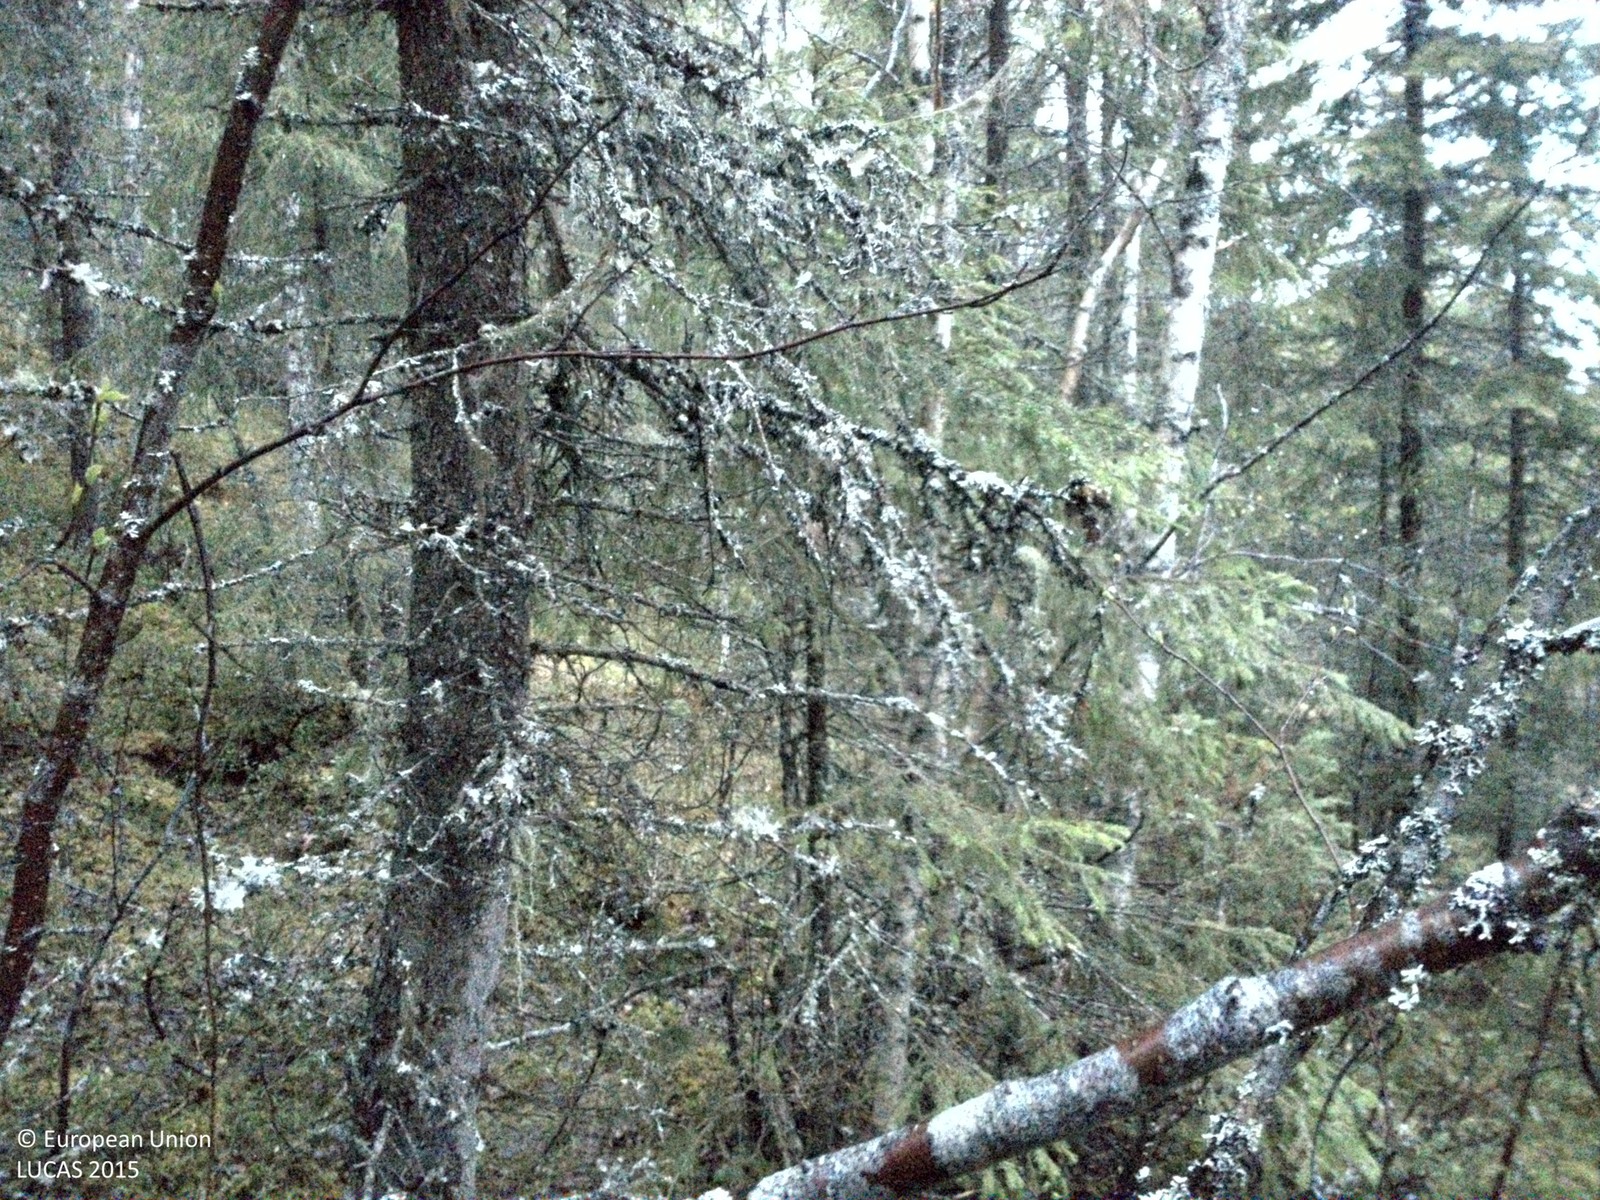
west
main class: Woodland
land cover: Spruce dominated mixed woodland
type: boreal forest
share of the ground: > 75 %
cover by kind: coniferous forest trees 65 %, broadleaved forest trees 25 %, shrubs 10 %
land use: Forestry
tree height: > 5 m
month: June
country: SE
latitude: 61.0267
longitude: 13.2278
